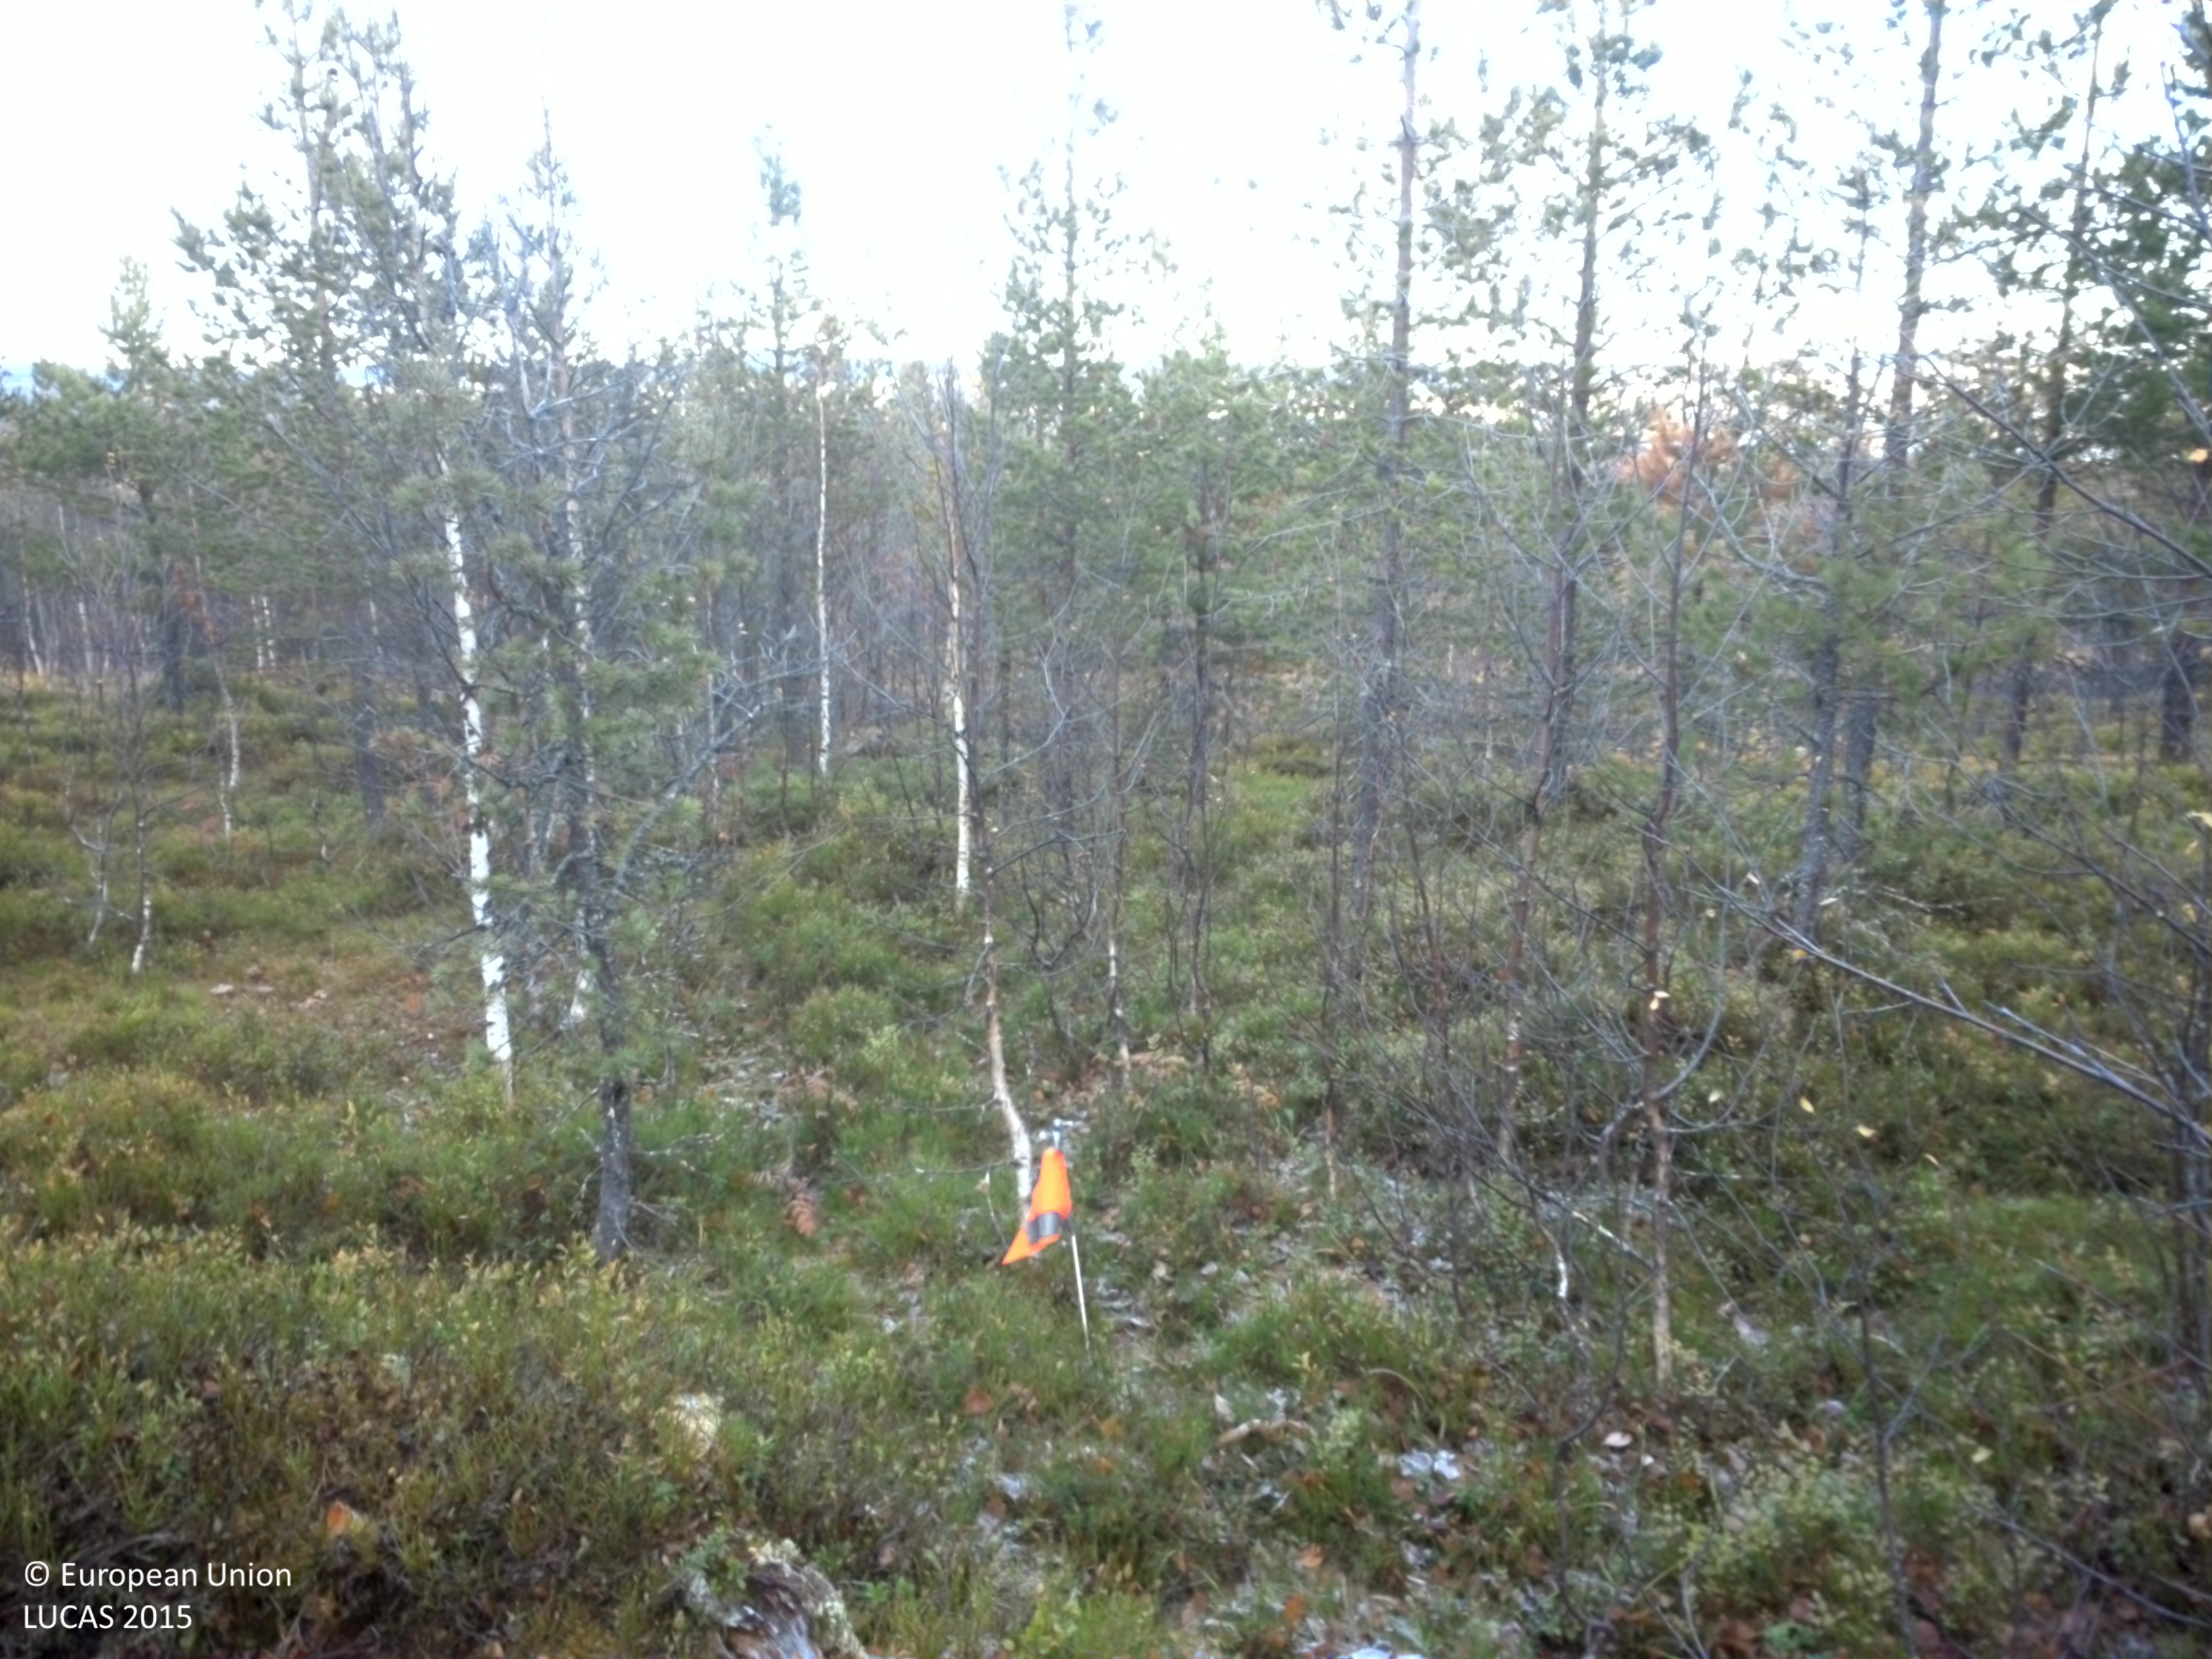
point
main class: Woodland
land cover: Pine dominated mixed woodland
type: boreal forest
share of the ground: 25 - 50 %
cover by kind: shrubs 40 %, coniferous forest trees 20 %, herbaceous plants 20 %, broadleaved forest trees 10 %, lichens and mosses 10 %
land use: Forestry
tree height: > 5 m
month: October
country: SE
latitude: 64.7648
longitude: 17.5122
